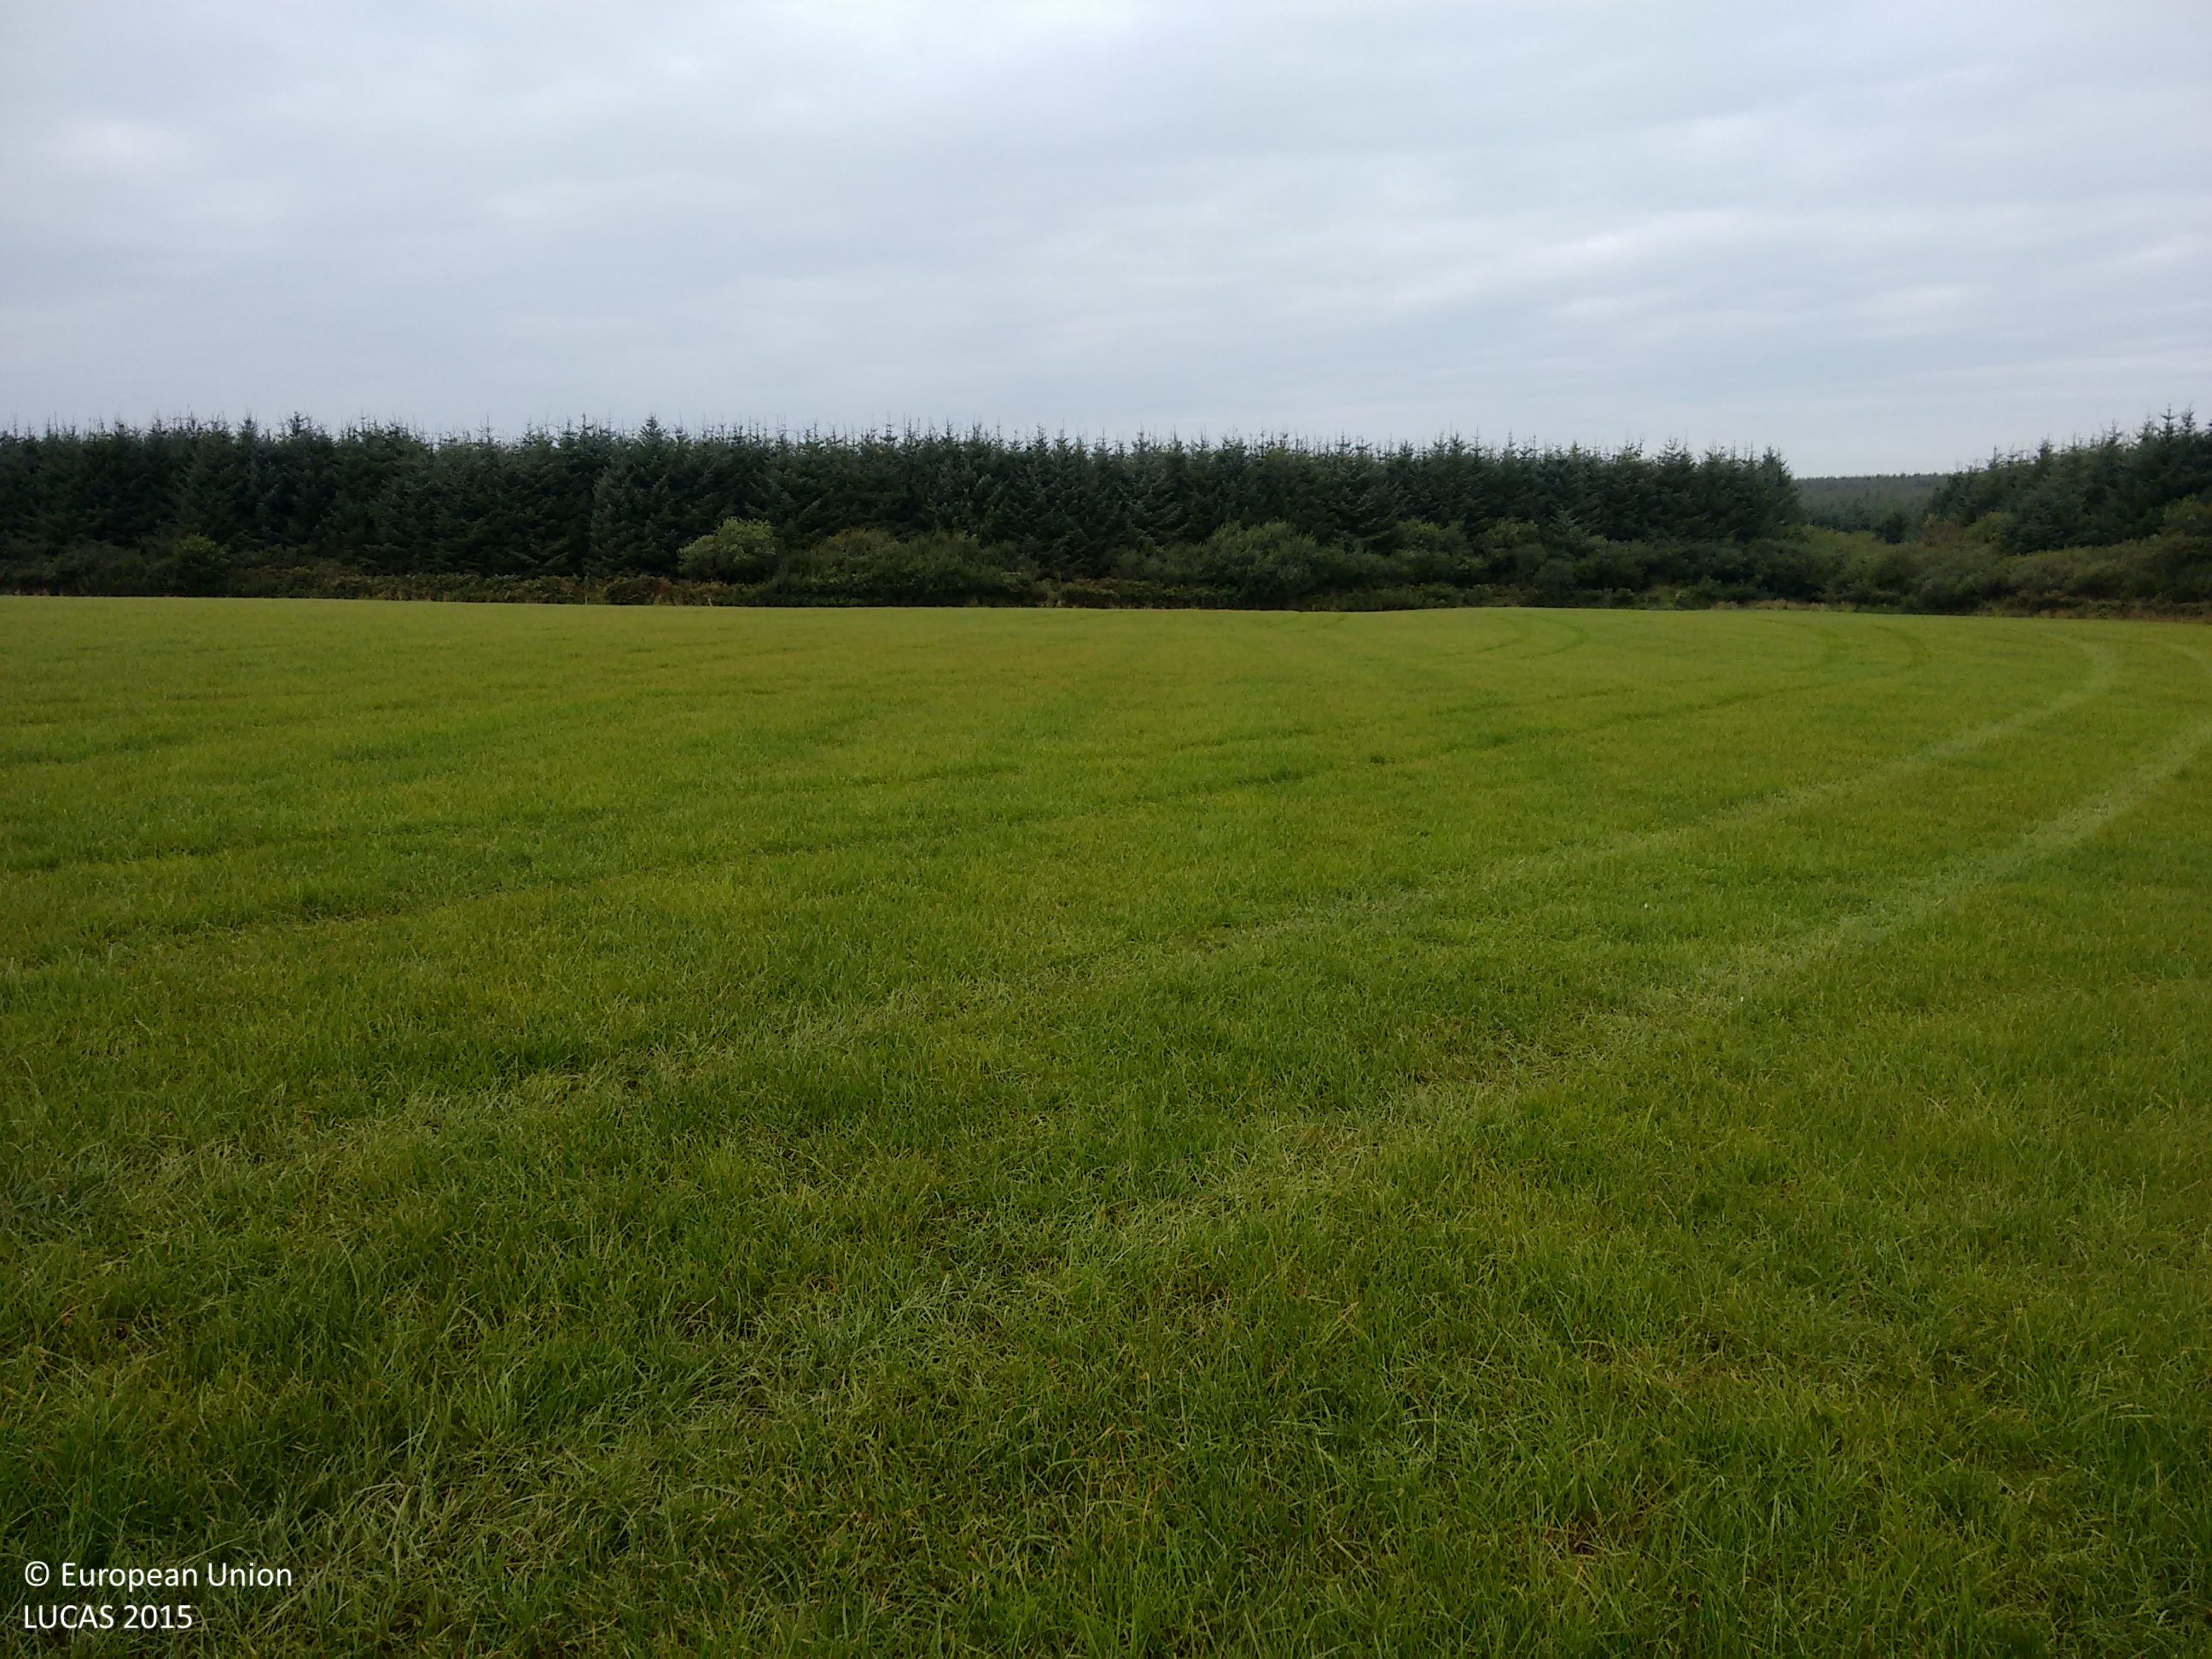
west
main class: Cropland
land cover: Temporary grasslands
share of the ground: > 75 %
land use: Agriculture (excluding fallow land and kitchen gardens)
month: September
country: GB
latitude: 50.9195
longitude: -4.4570
